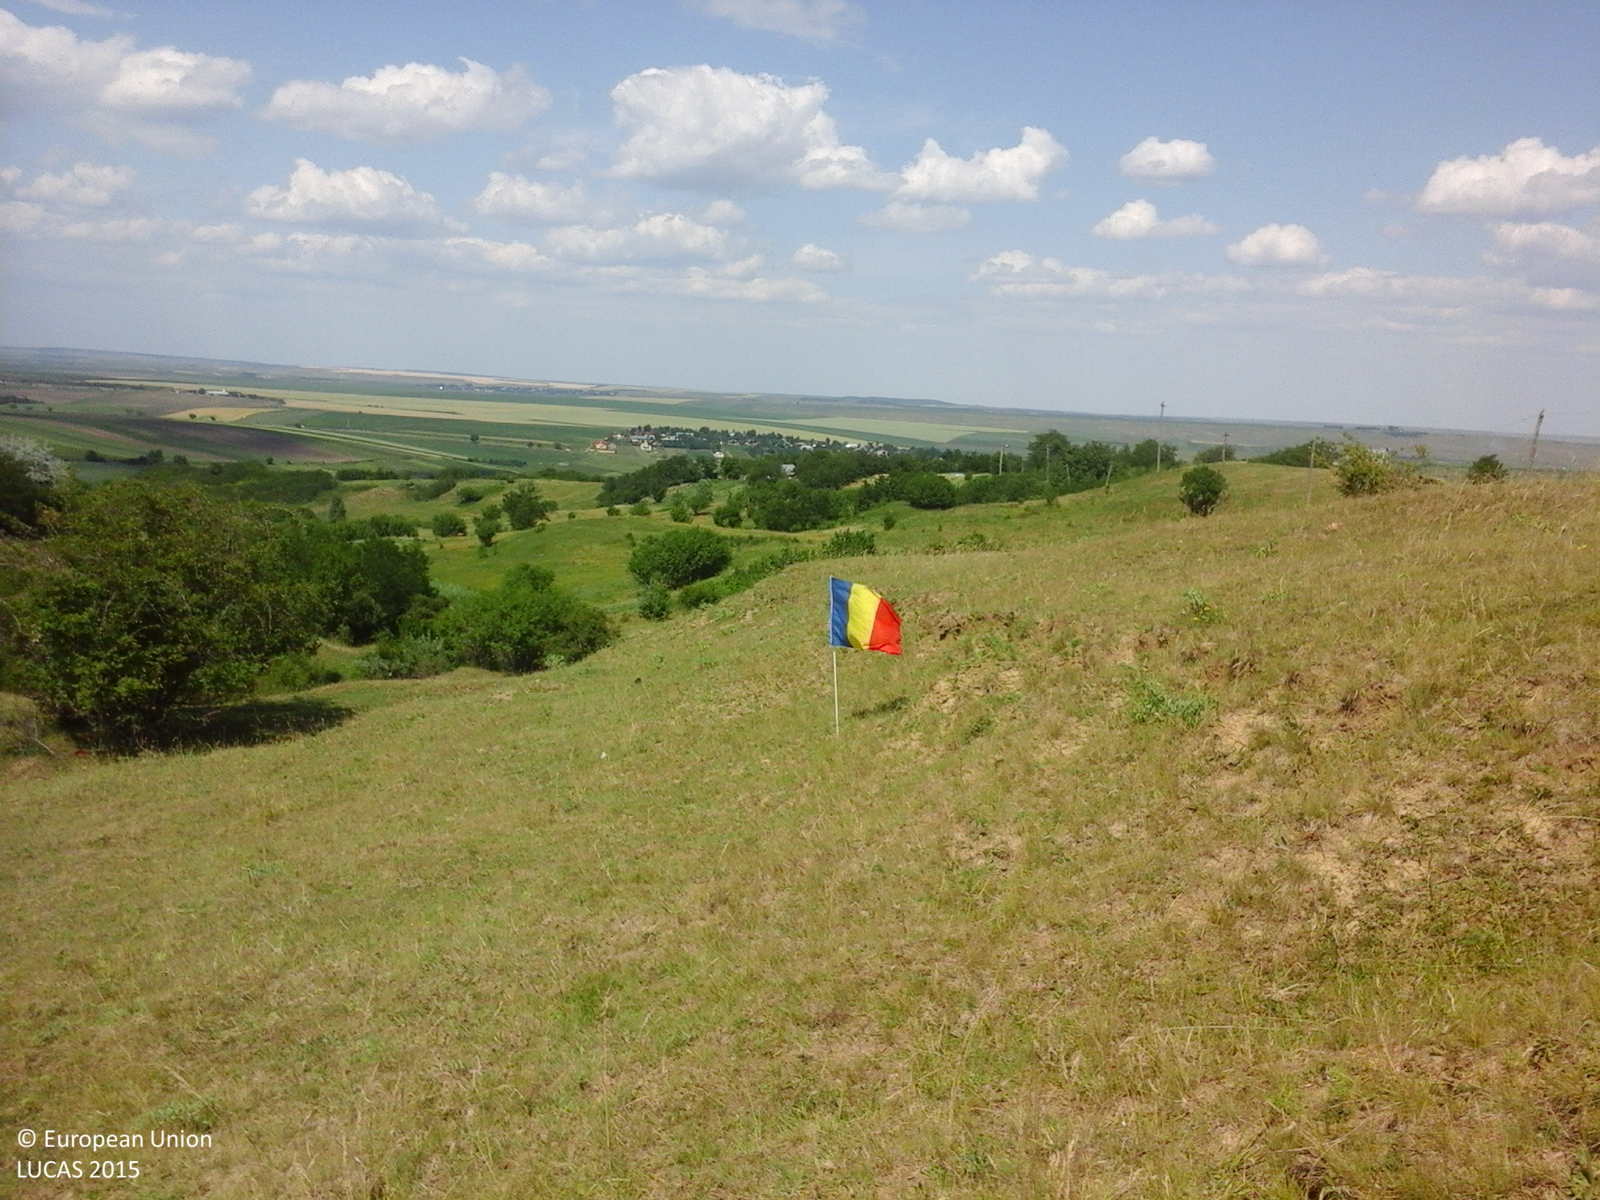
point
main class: Grassland
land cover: Grassland without tree/shrub cover
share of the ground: > 75 %
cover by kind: herbaceous plants 100 %
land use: Agriculture (excluding fallow land and kitchen gardens)
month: June
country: RO
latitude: 47.7955
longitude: 26.4980
